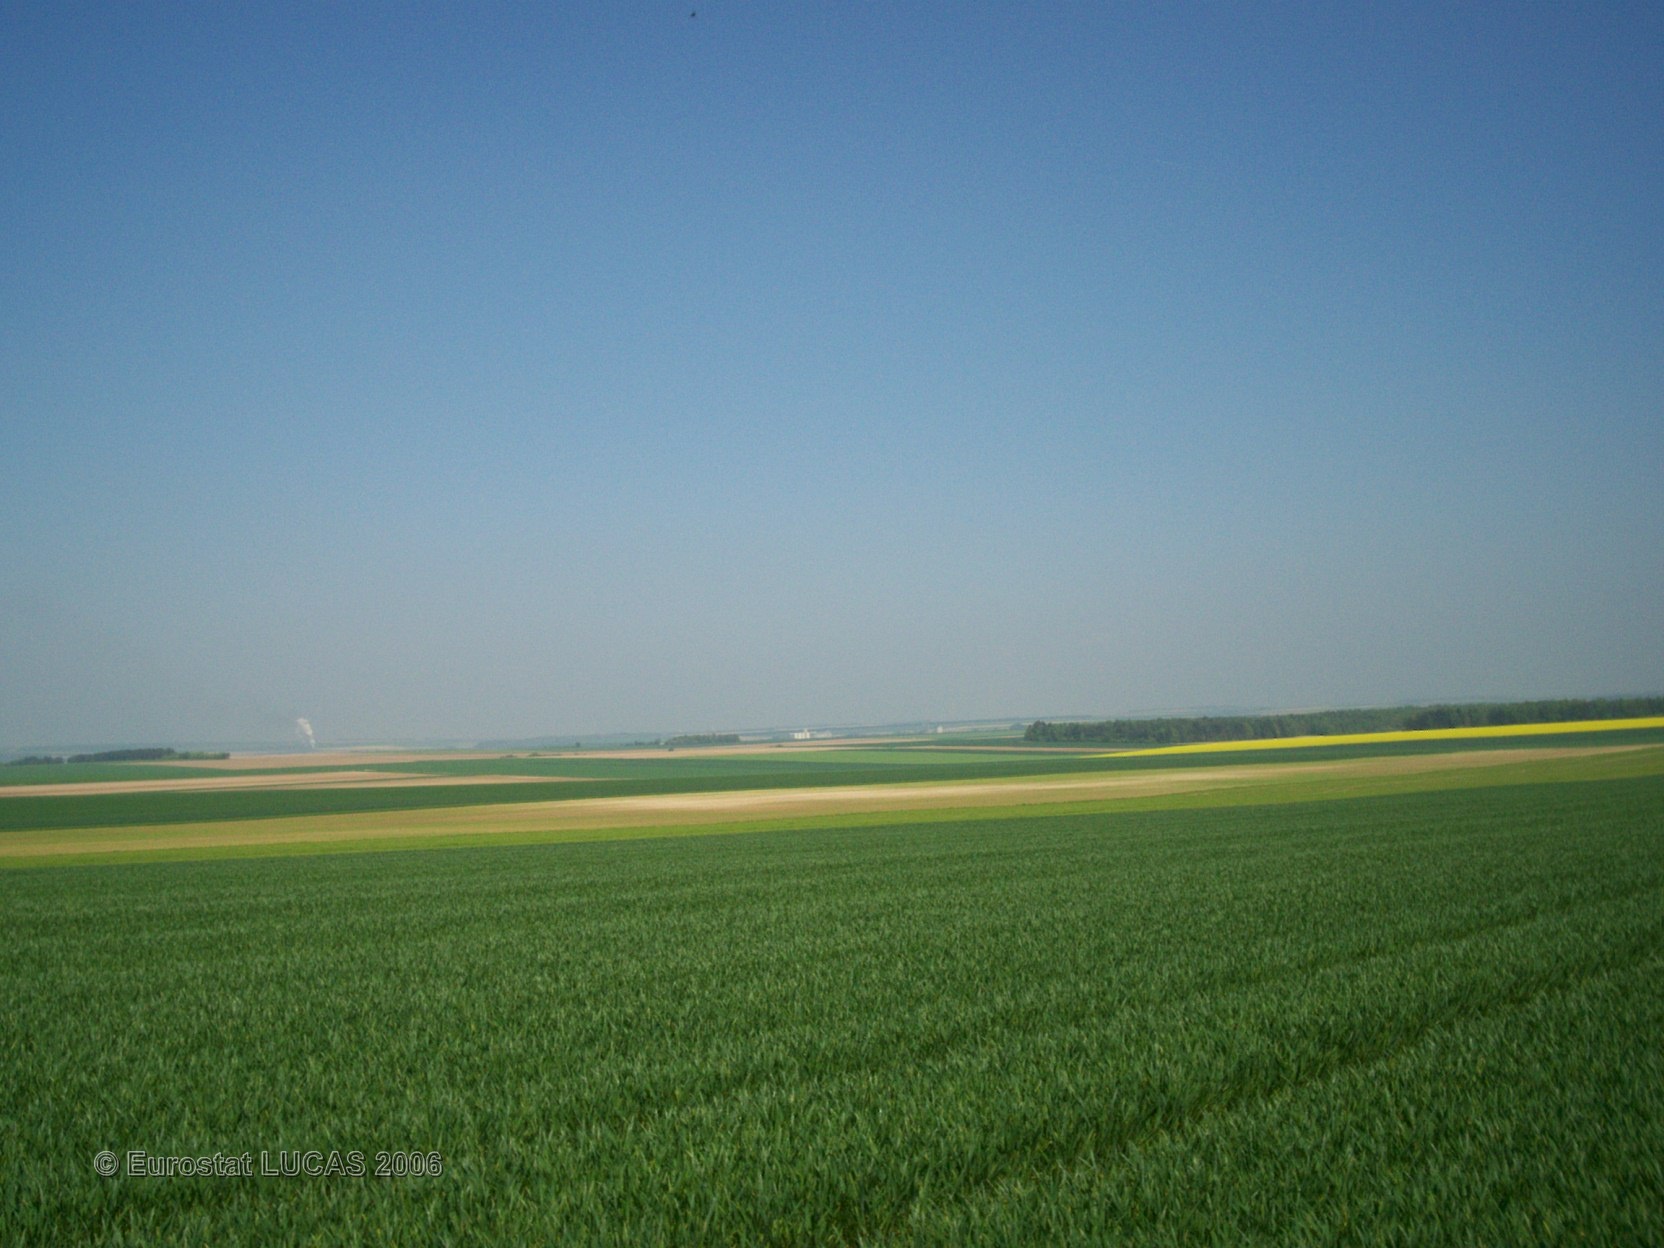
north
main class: Cropland
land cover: Common wheat
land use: Agriculture (excluding fallow land and kitchen gardens)
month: May
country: FR
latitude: 49.2509
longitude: 4.3496
